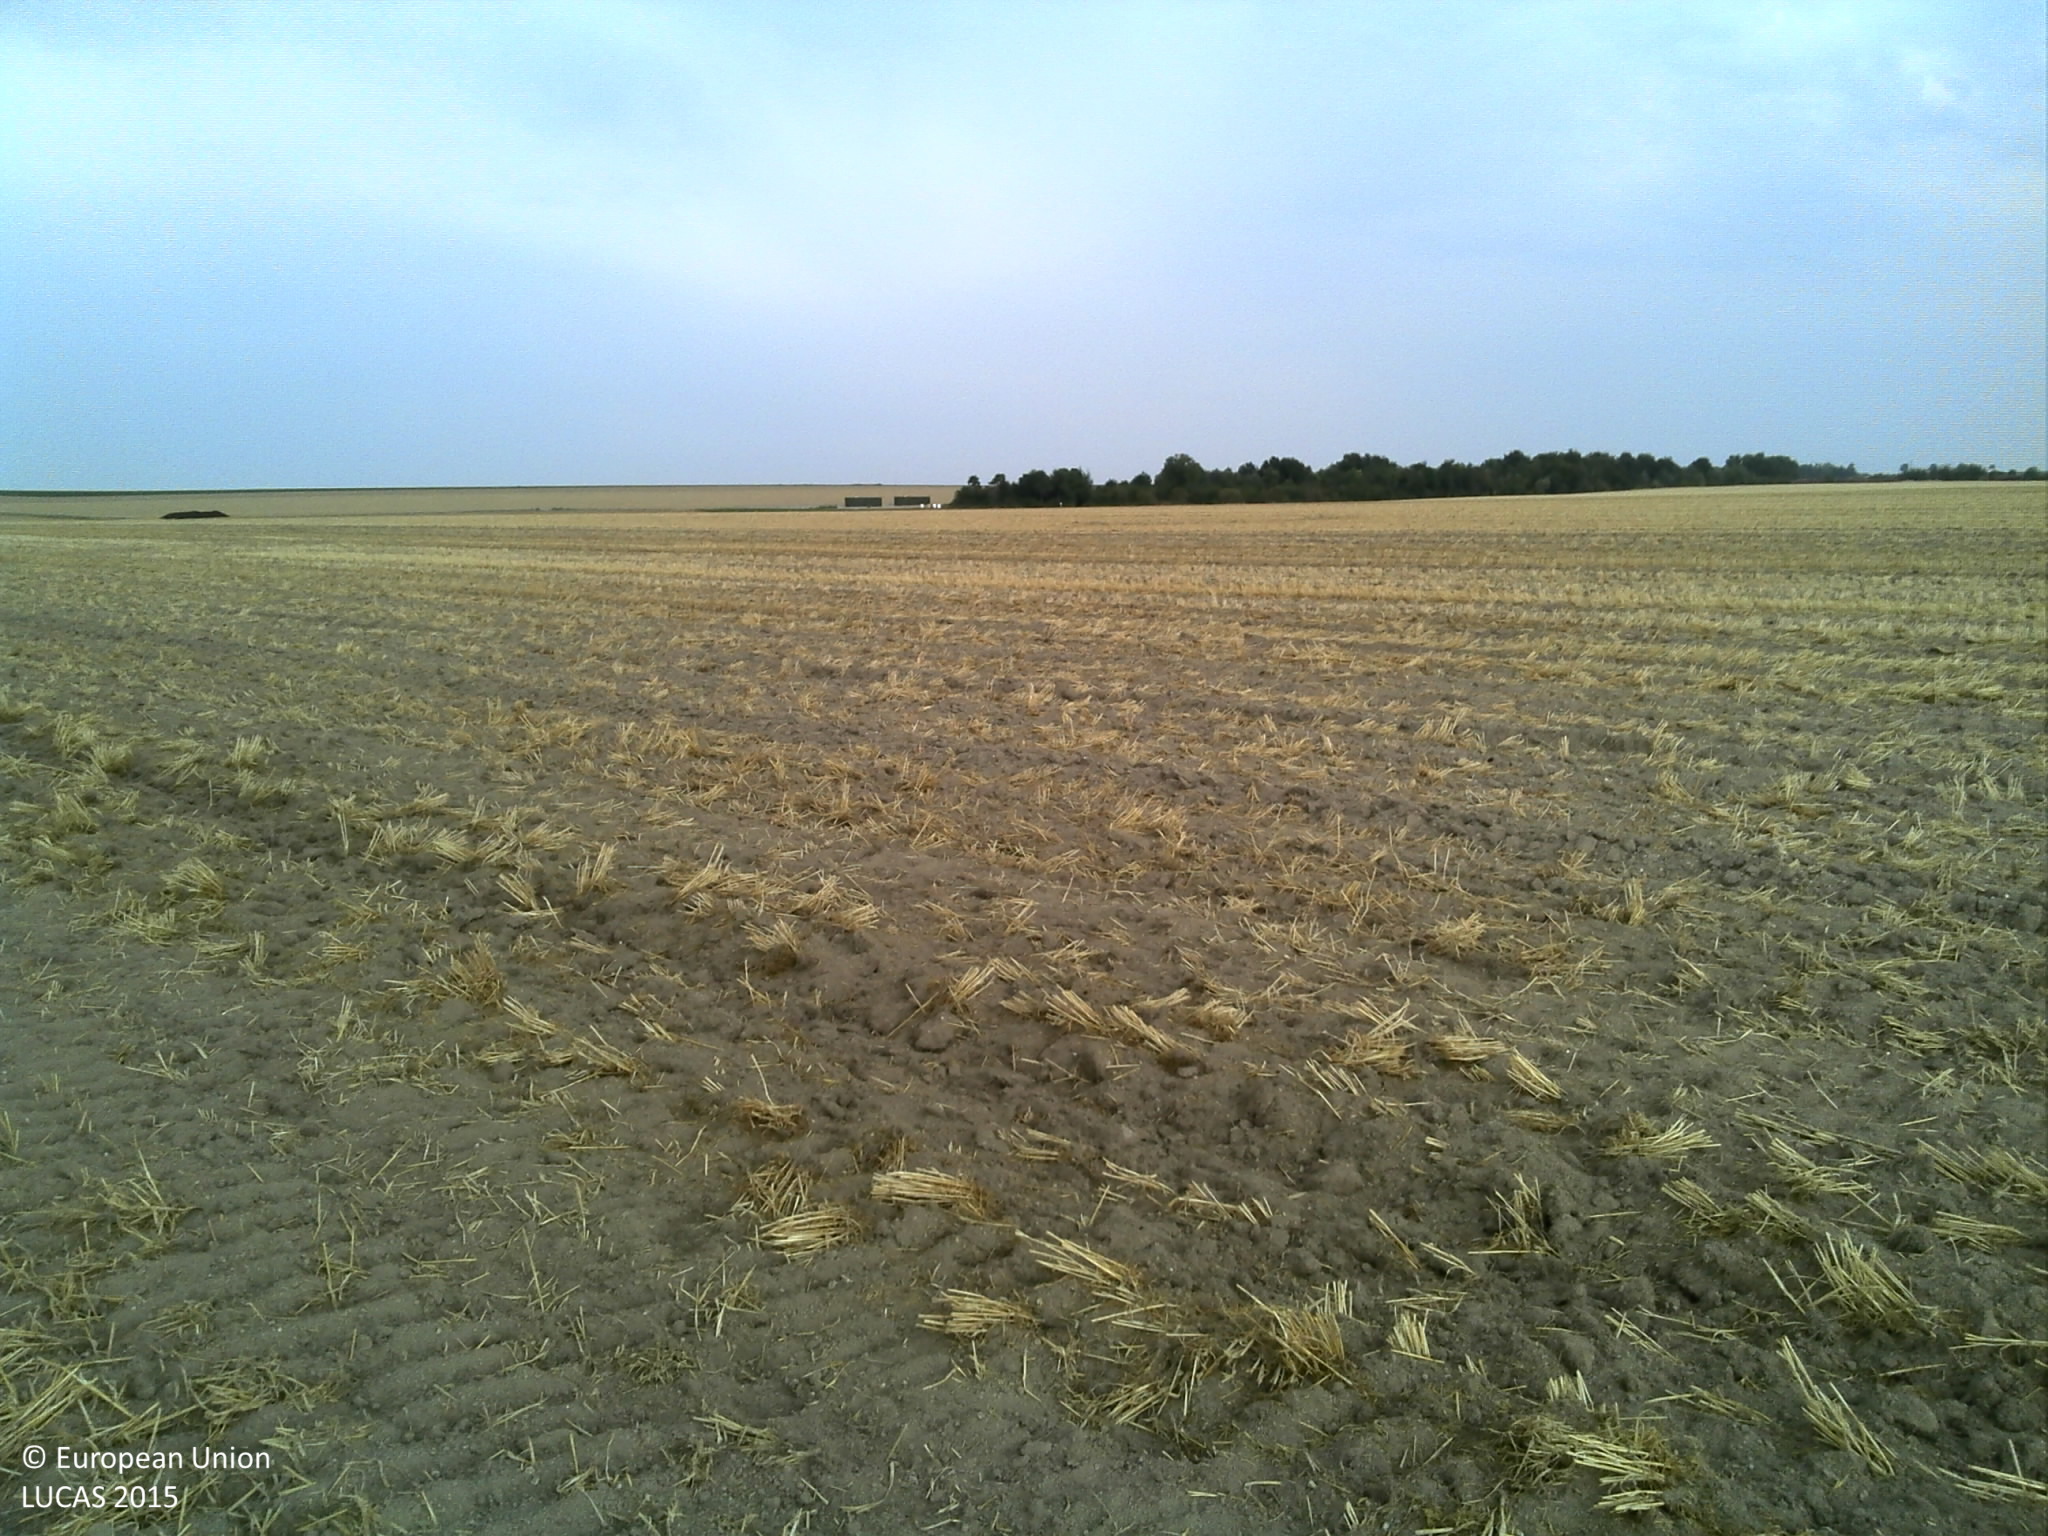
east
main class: Cropland
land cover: Barley
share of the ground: > 75 %
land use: Agriculture (excluding fallow land and kitchen gardens)
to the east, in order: Barley
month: August
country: FR
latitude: 48.9019
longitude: 4.2254
